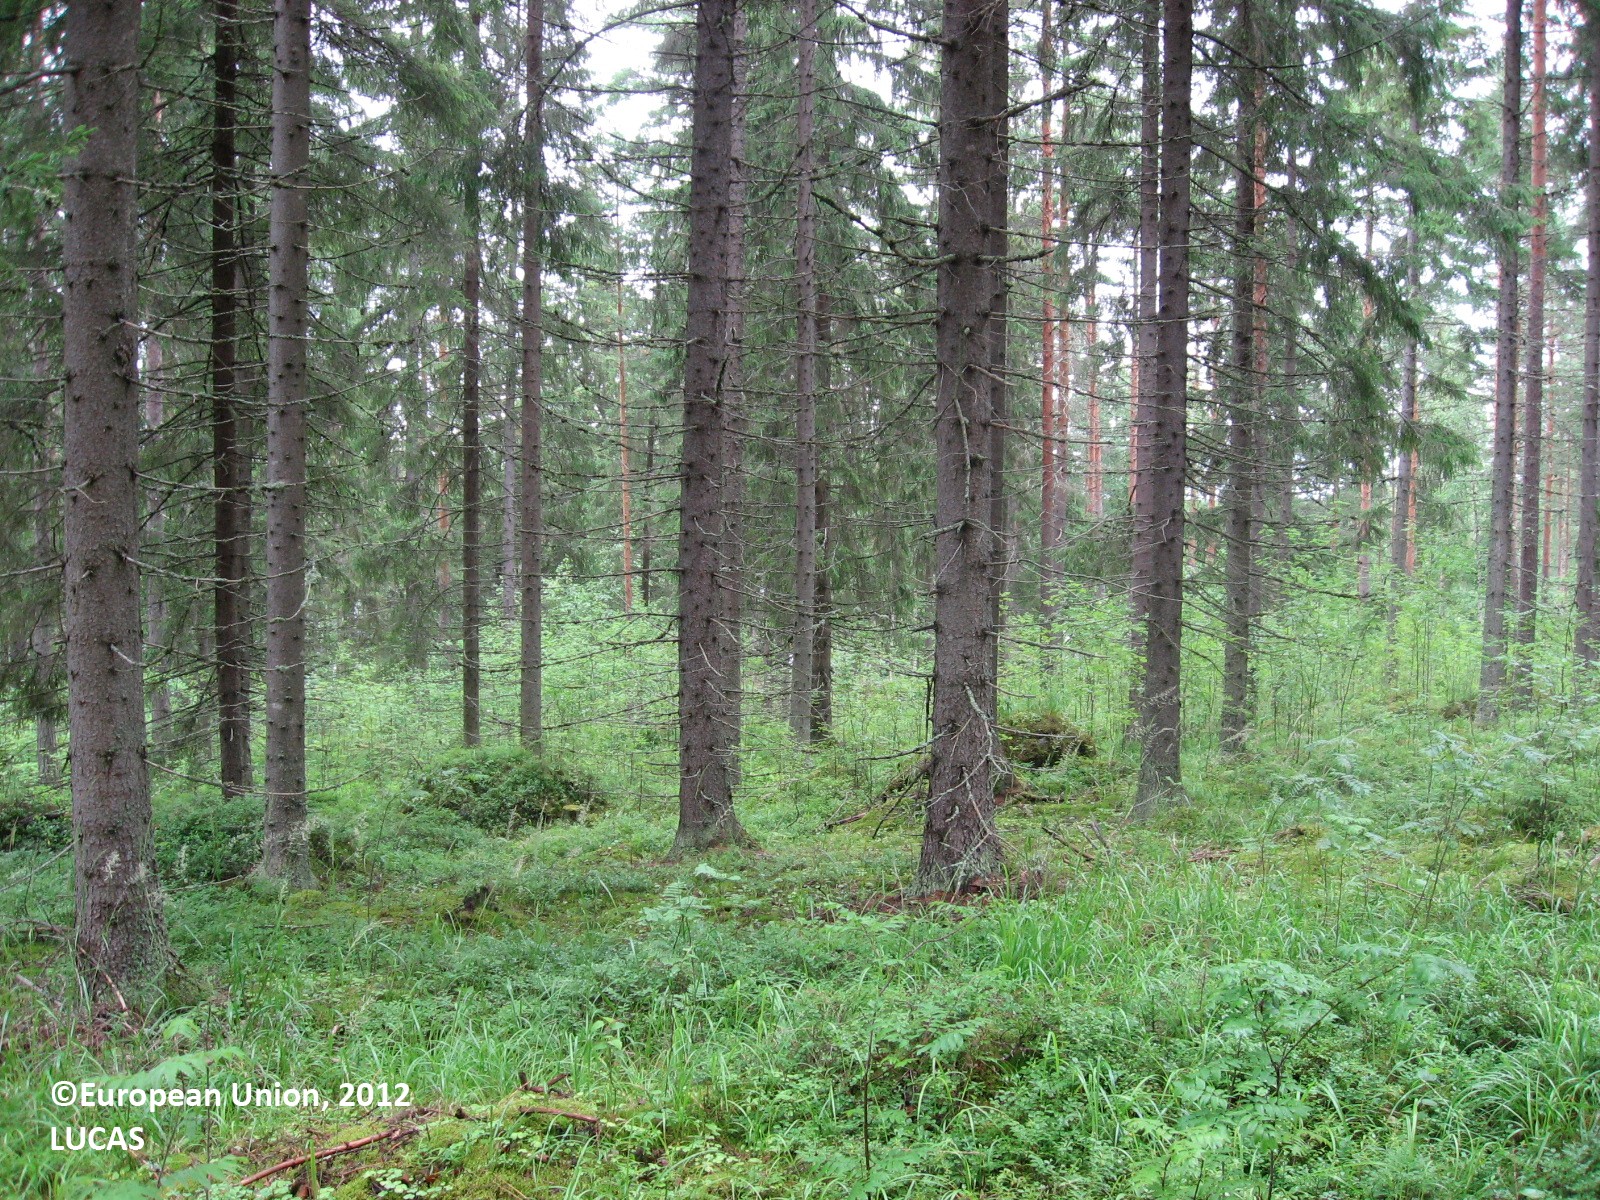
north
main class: Woodland
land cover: Spruce dominated coniferous woodland
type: boreal forest
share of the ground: 50 - 75 %
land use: Forestry
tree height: > 5 m
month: July
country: FI
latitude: 61.2271
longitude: 25.8700
